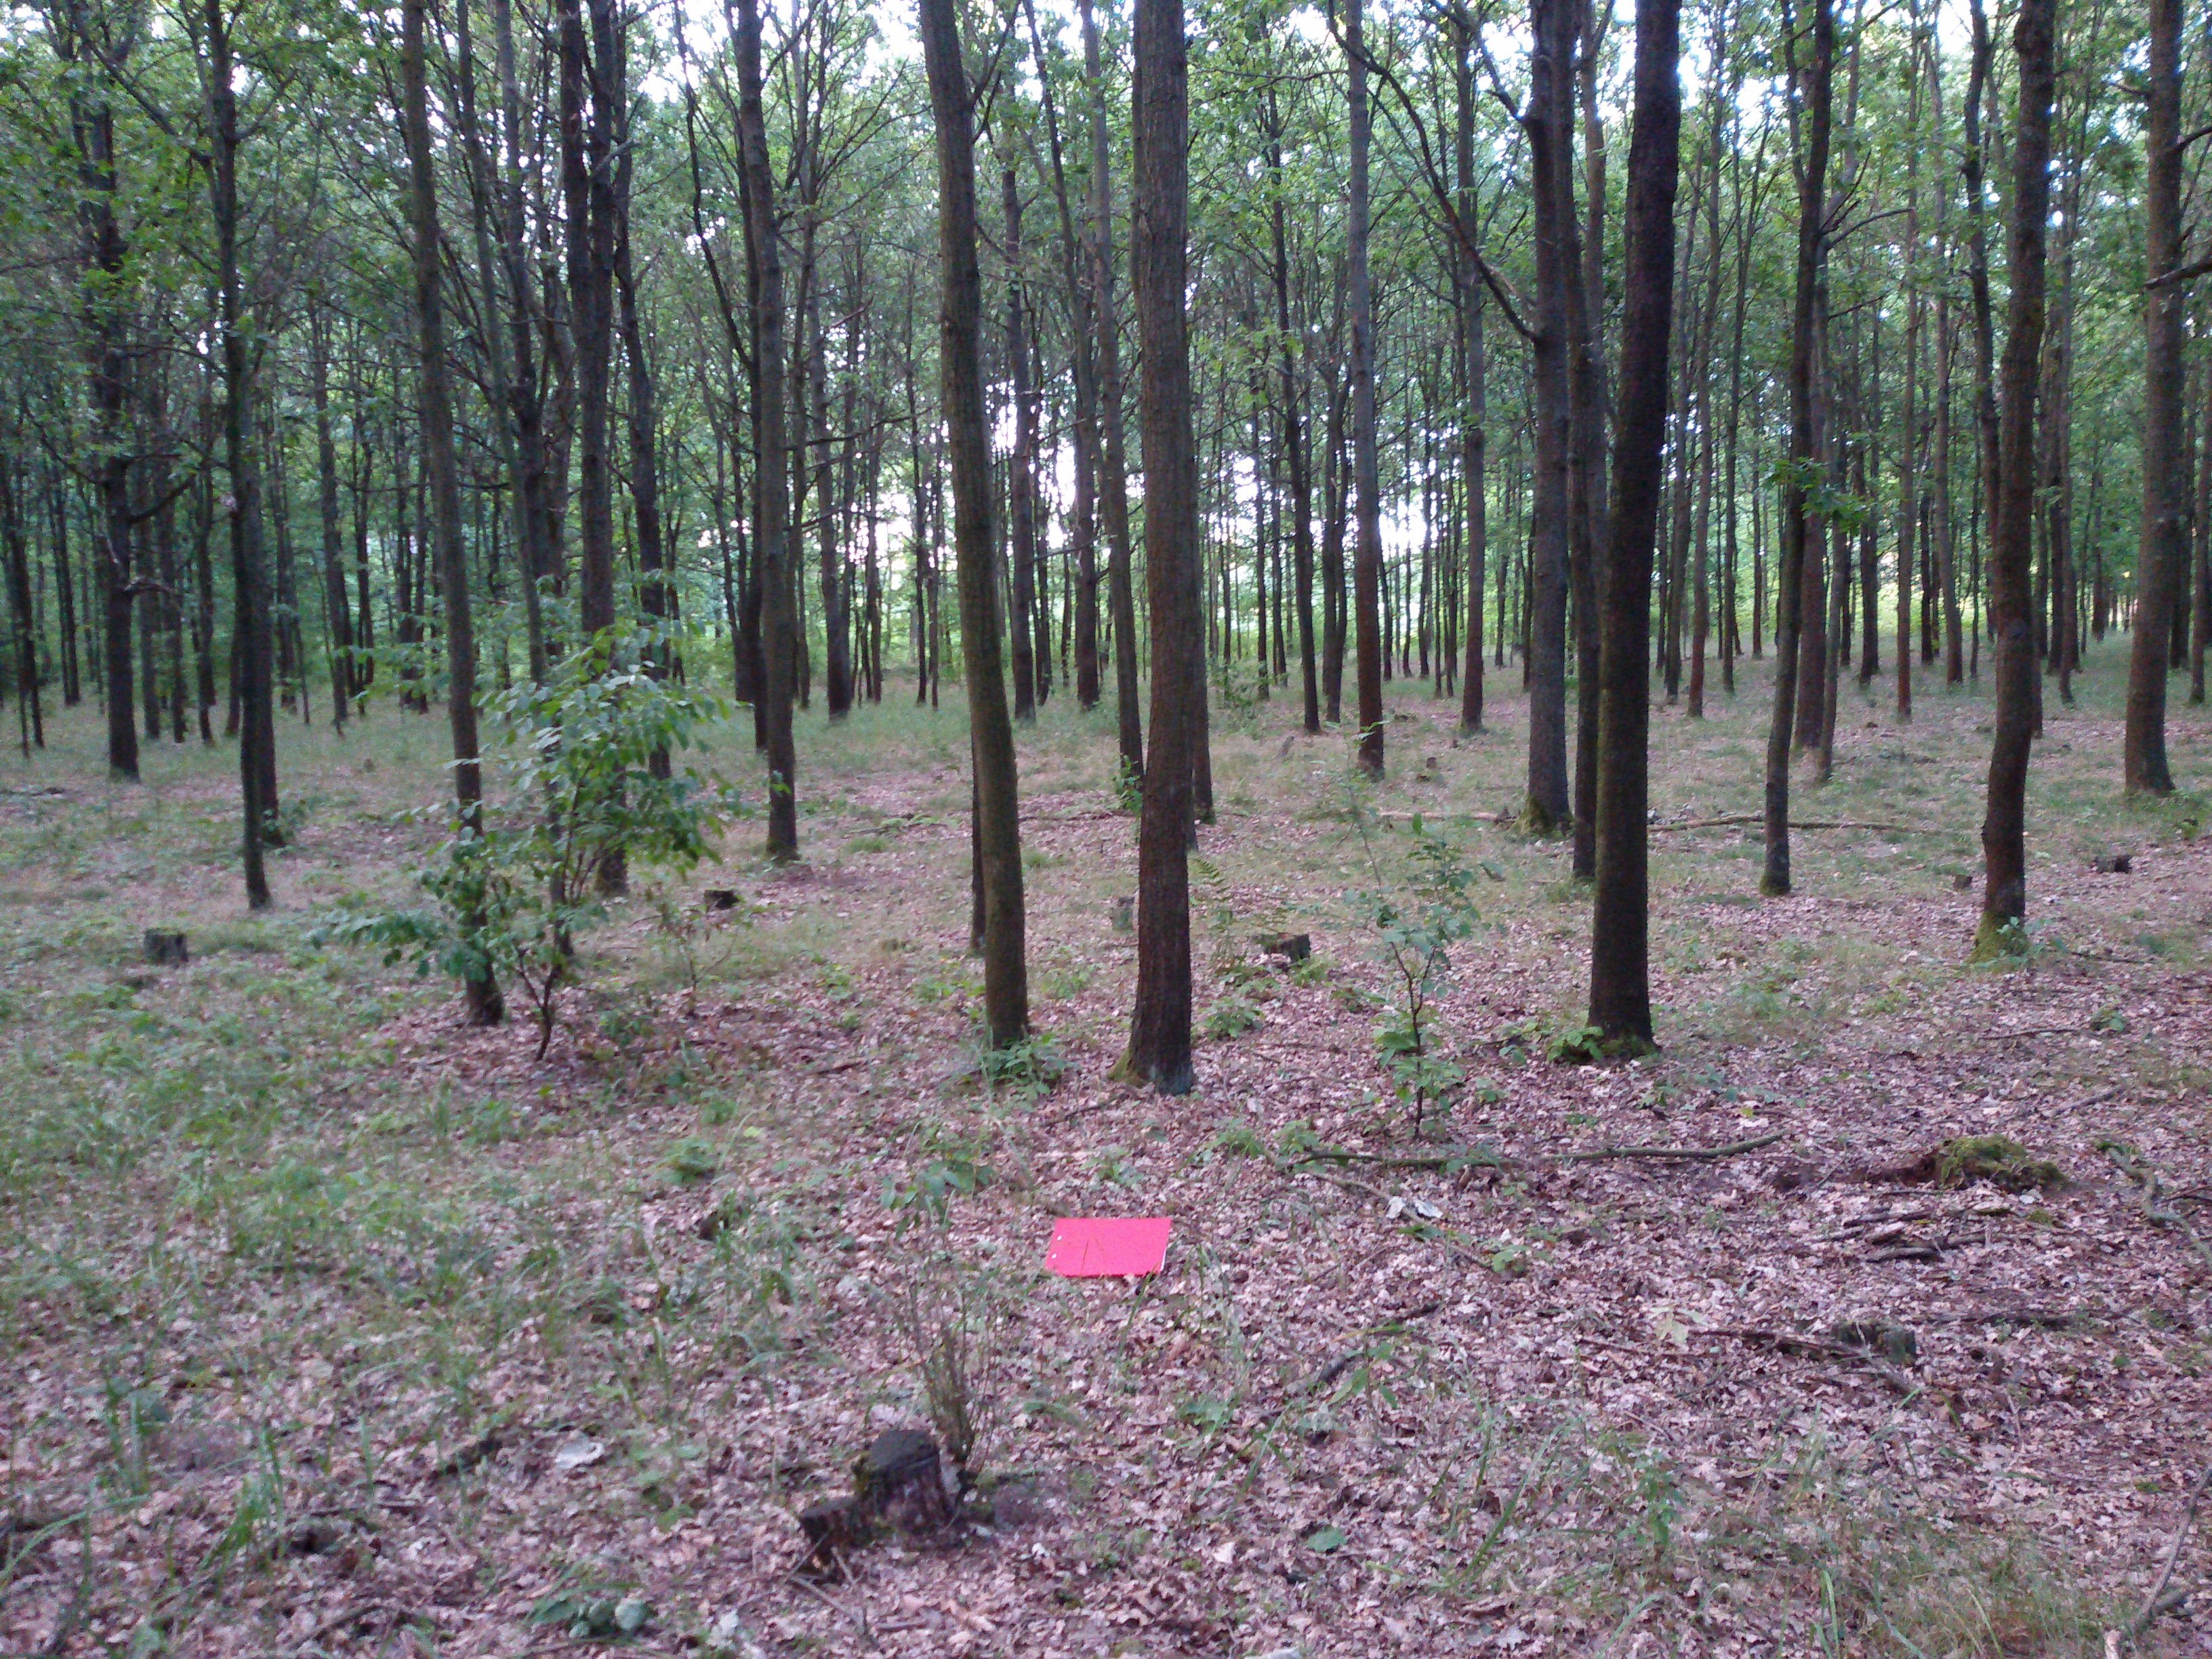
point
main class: Woodland
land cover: Broadleaved woodland
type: mesophytic deciduous forest
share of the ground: 50 - 75 %
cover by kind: broadleaved forest trees 70 %, herbaceous plants 20 %, unconsolidated bare surface 10 %
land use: Forestry
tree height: > 5 m
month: July
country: PL
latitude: 52.0699
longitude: 17.4672
